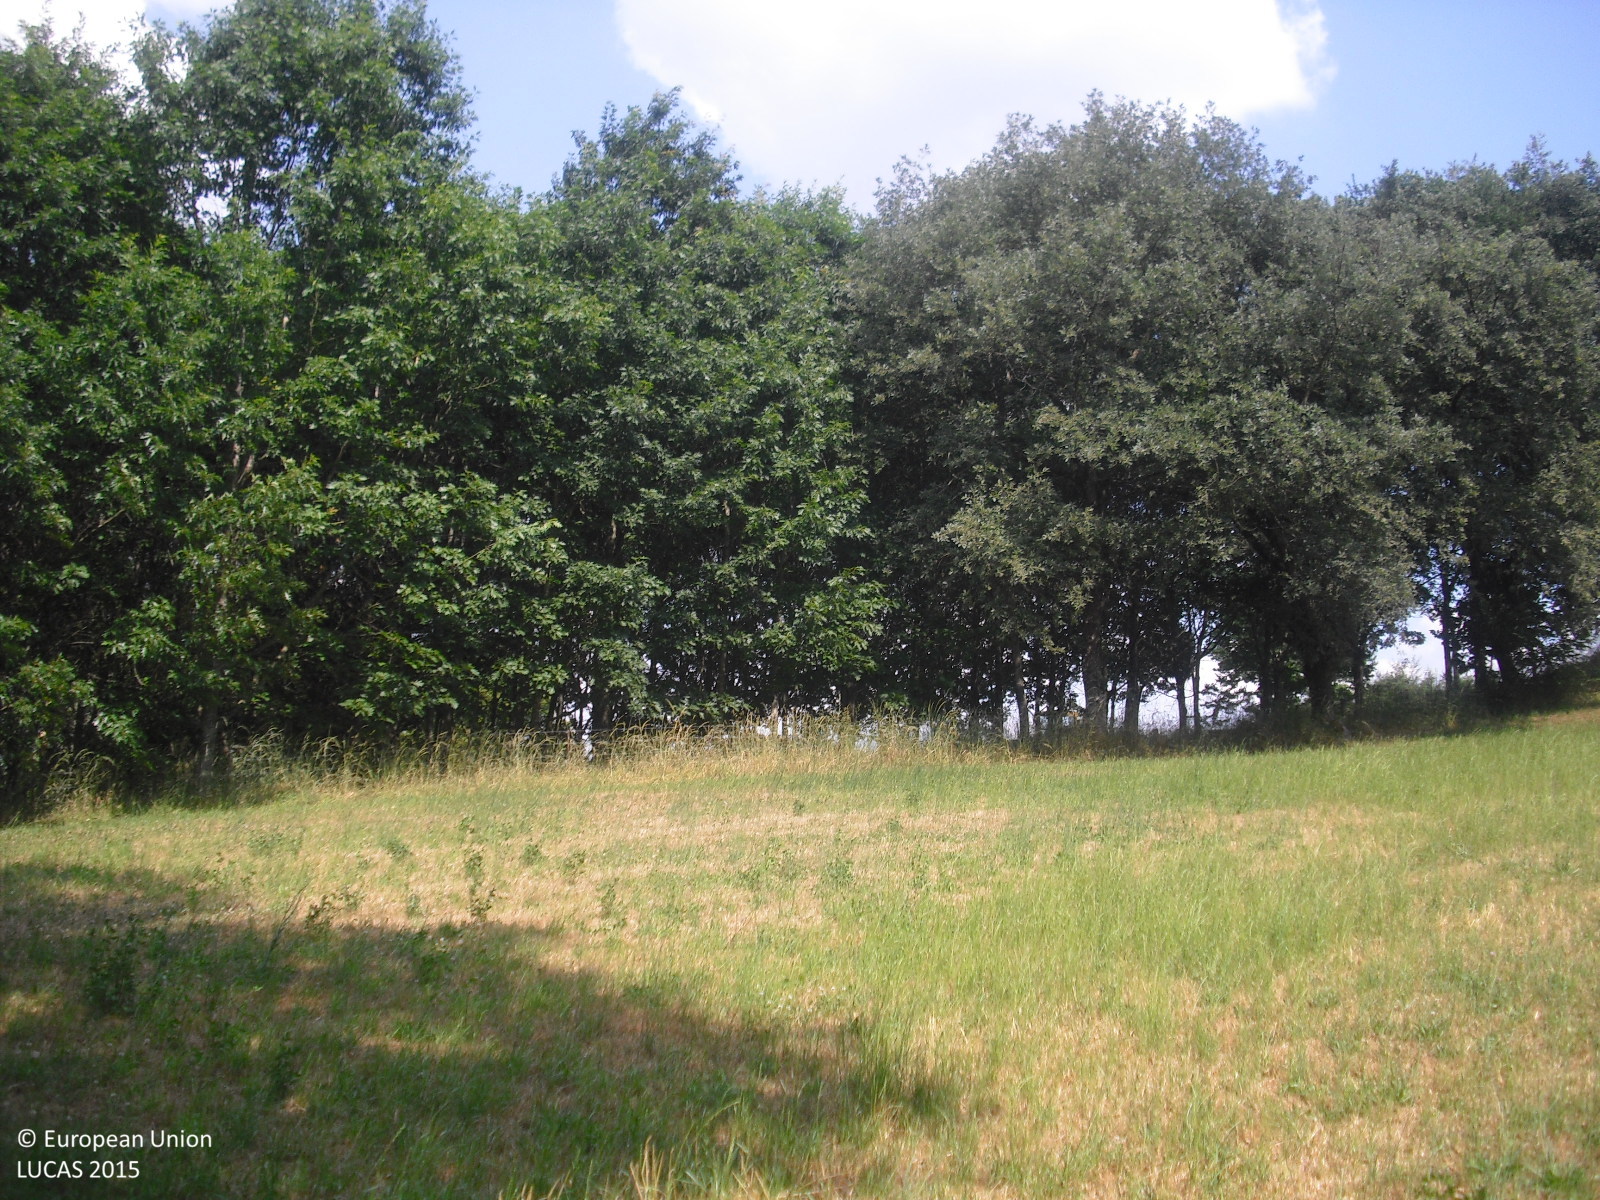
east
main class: Cropland
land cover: Temporary grasslands
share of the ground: > 75 %
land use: Agriculture (excluding fallow land and kitchen gardens)
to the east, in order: Temporary grasslands; Fences; Broadleaved woodland; Fences; Paved roads, cycling and walking lanes; Ditches and canals; Shruby margins; Temporary grasslands; Tracks; Temporary grasslands; Dry stone walls; Fences; Temporary grasslands; Grassland with sparse tree/shrub cover; Fences; Other fresh vegetables; Potatoes; Artificial constructions in urban areas; Other root crops; Tracks
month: June
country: ES
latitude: 42.6308
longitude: -7.7970
